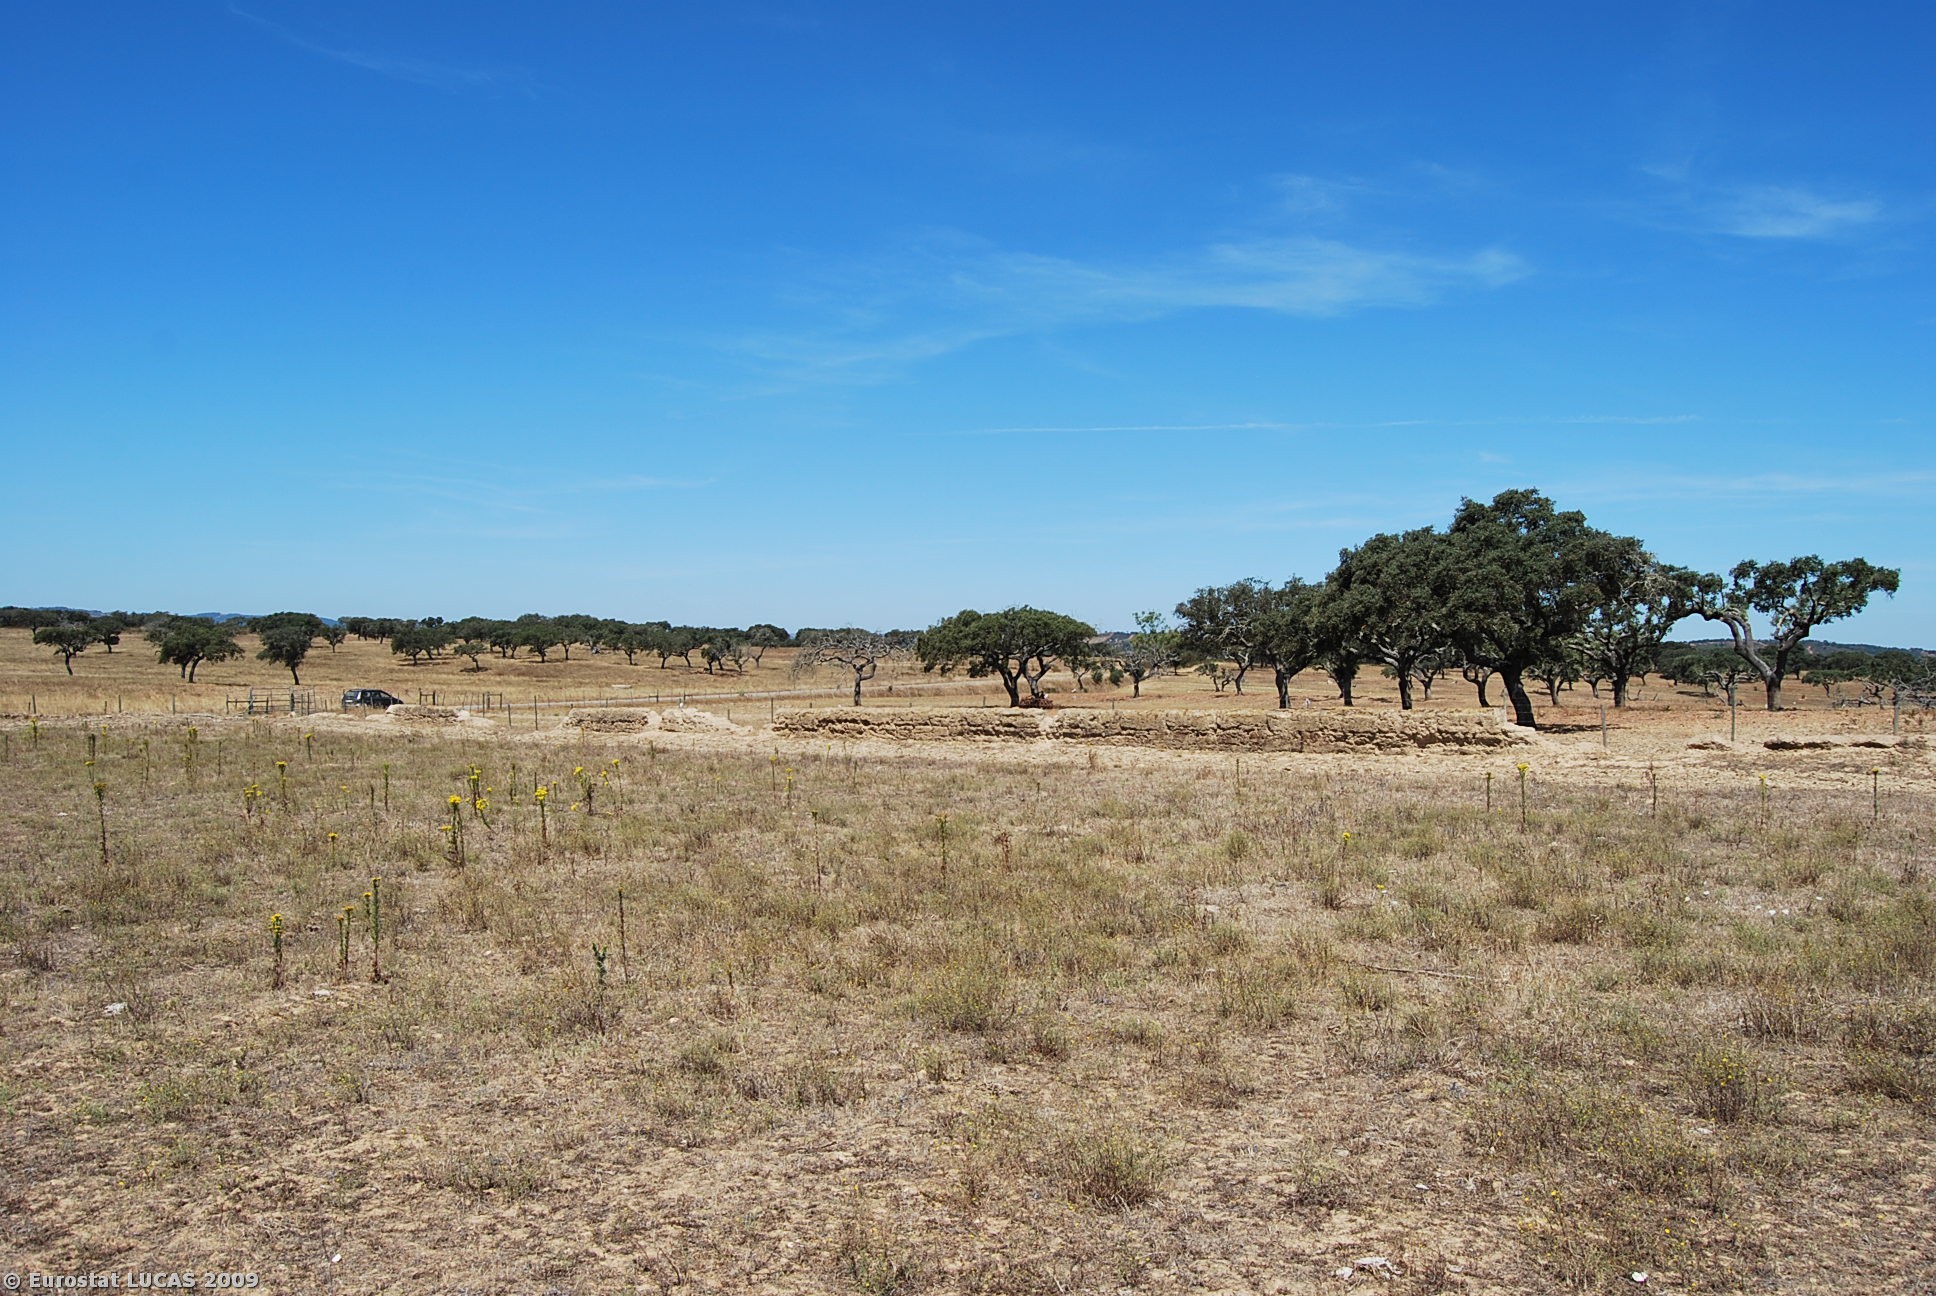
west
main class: Grassland
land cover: Grassland without tree/shrub cover
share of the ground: > 75 %
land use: Agriculture (excluding fallow land and kitchen gardens)
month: July
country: PT
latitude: 37.6829
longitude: -8.2756
